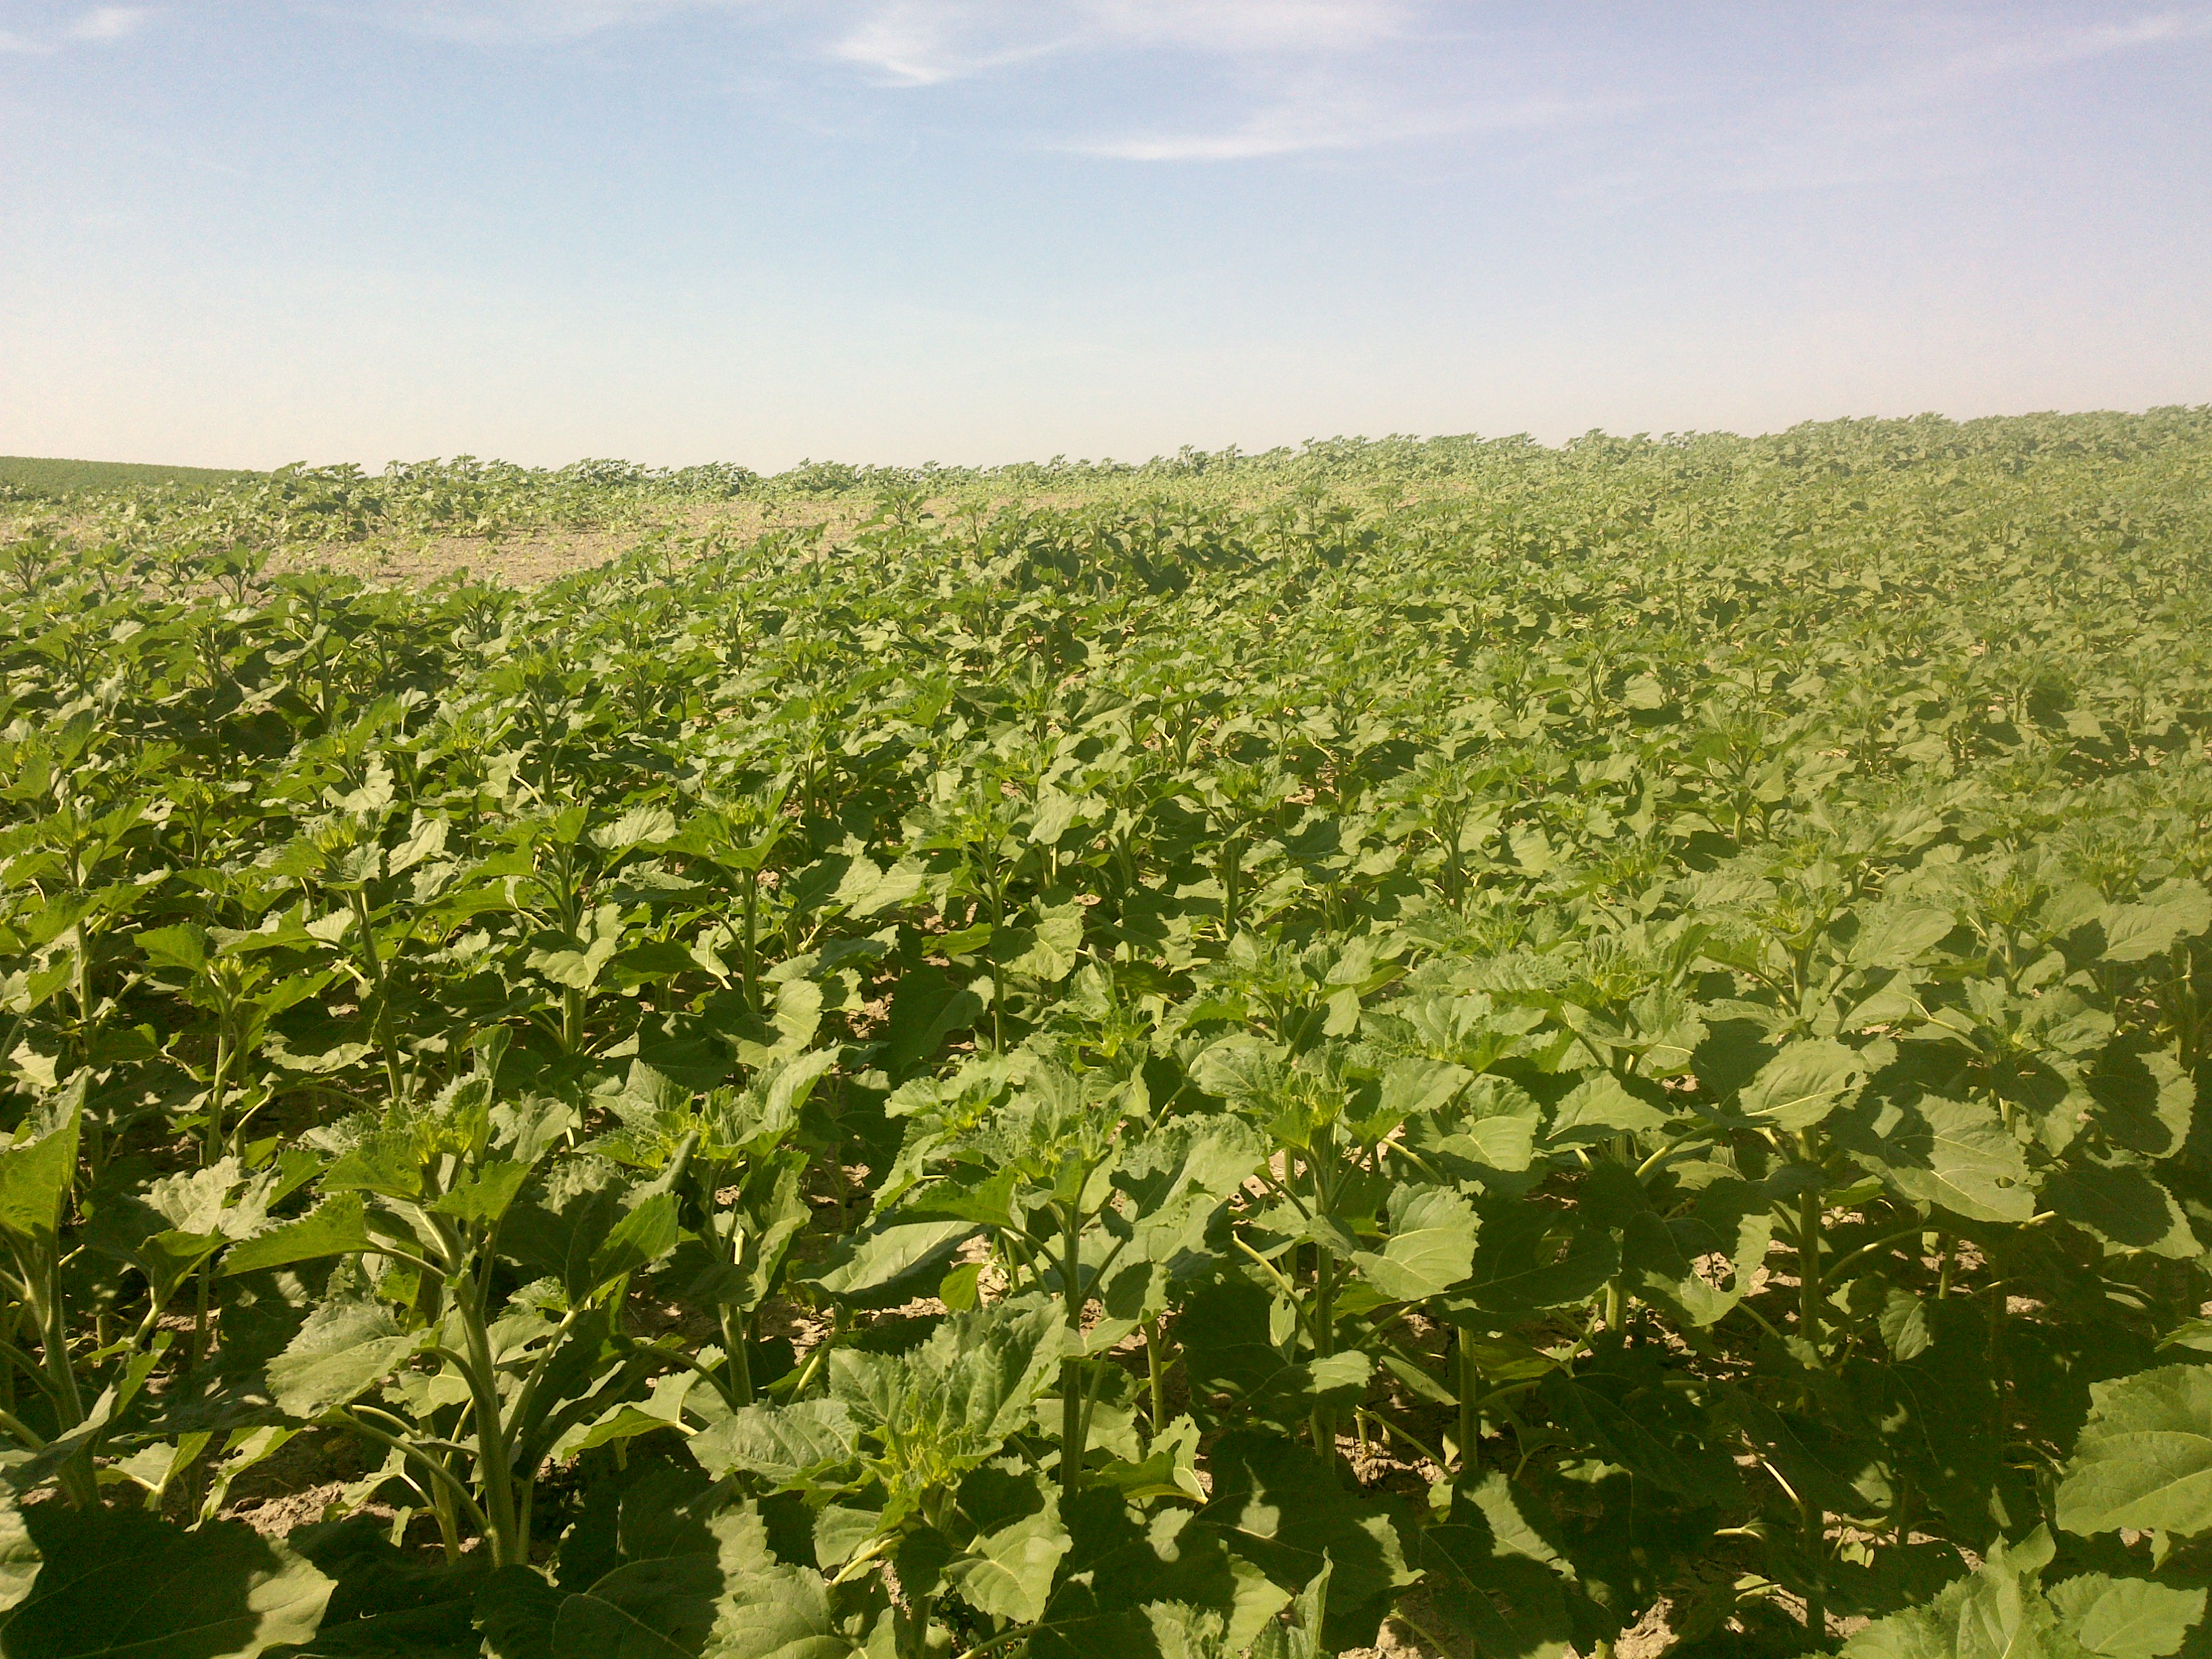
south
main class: Cropland
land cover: Sunflower
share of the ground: > 75 %
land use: Agriculture (excluding fallow land and kitchen gardens)
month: May
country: ES
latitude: 37.8193
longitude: -4.6548
